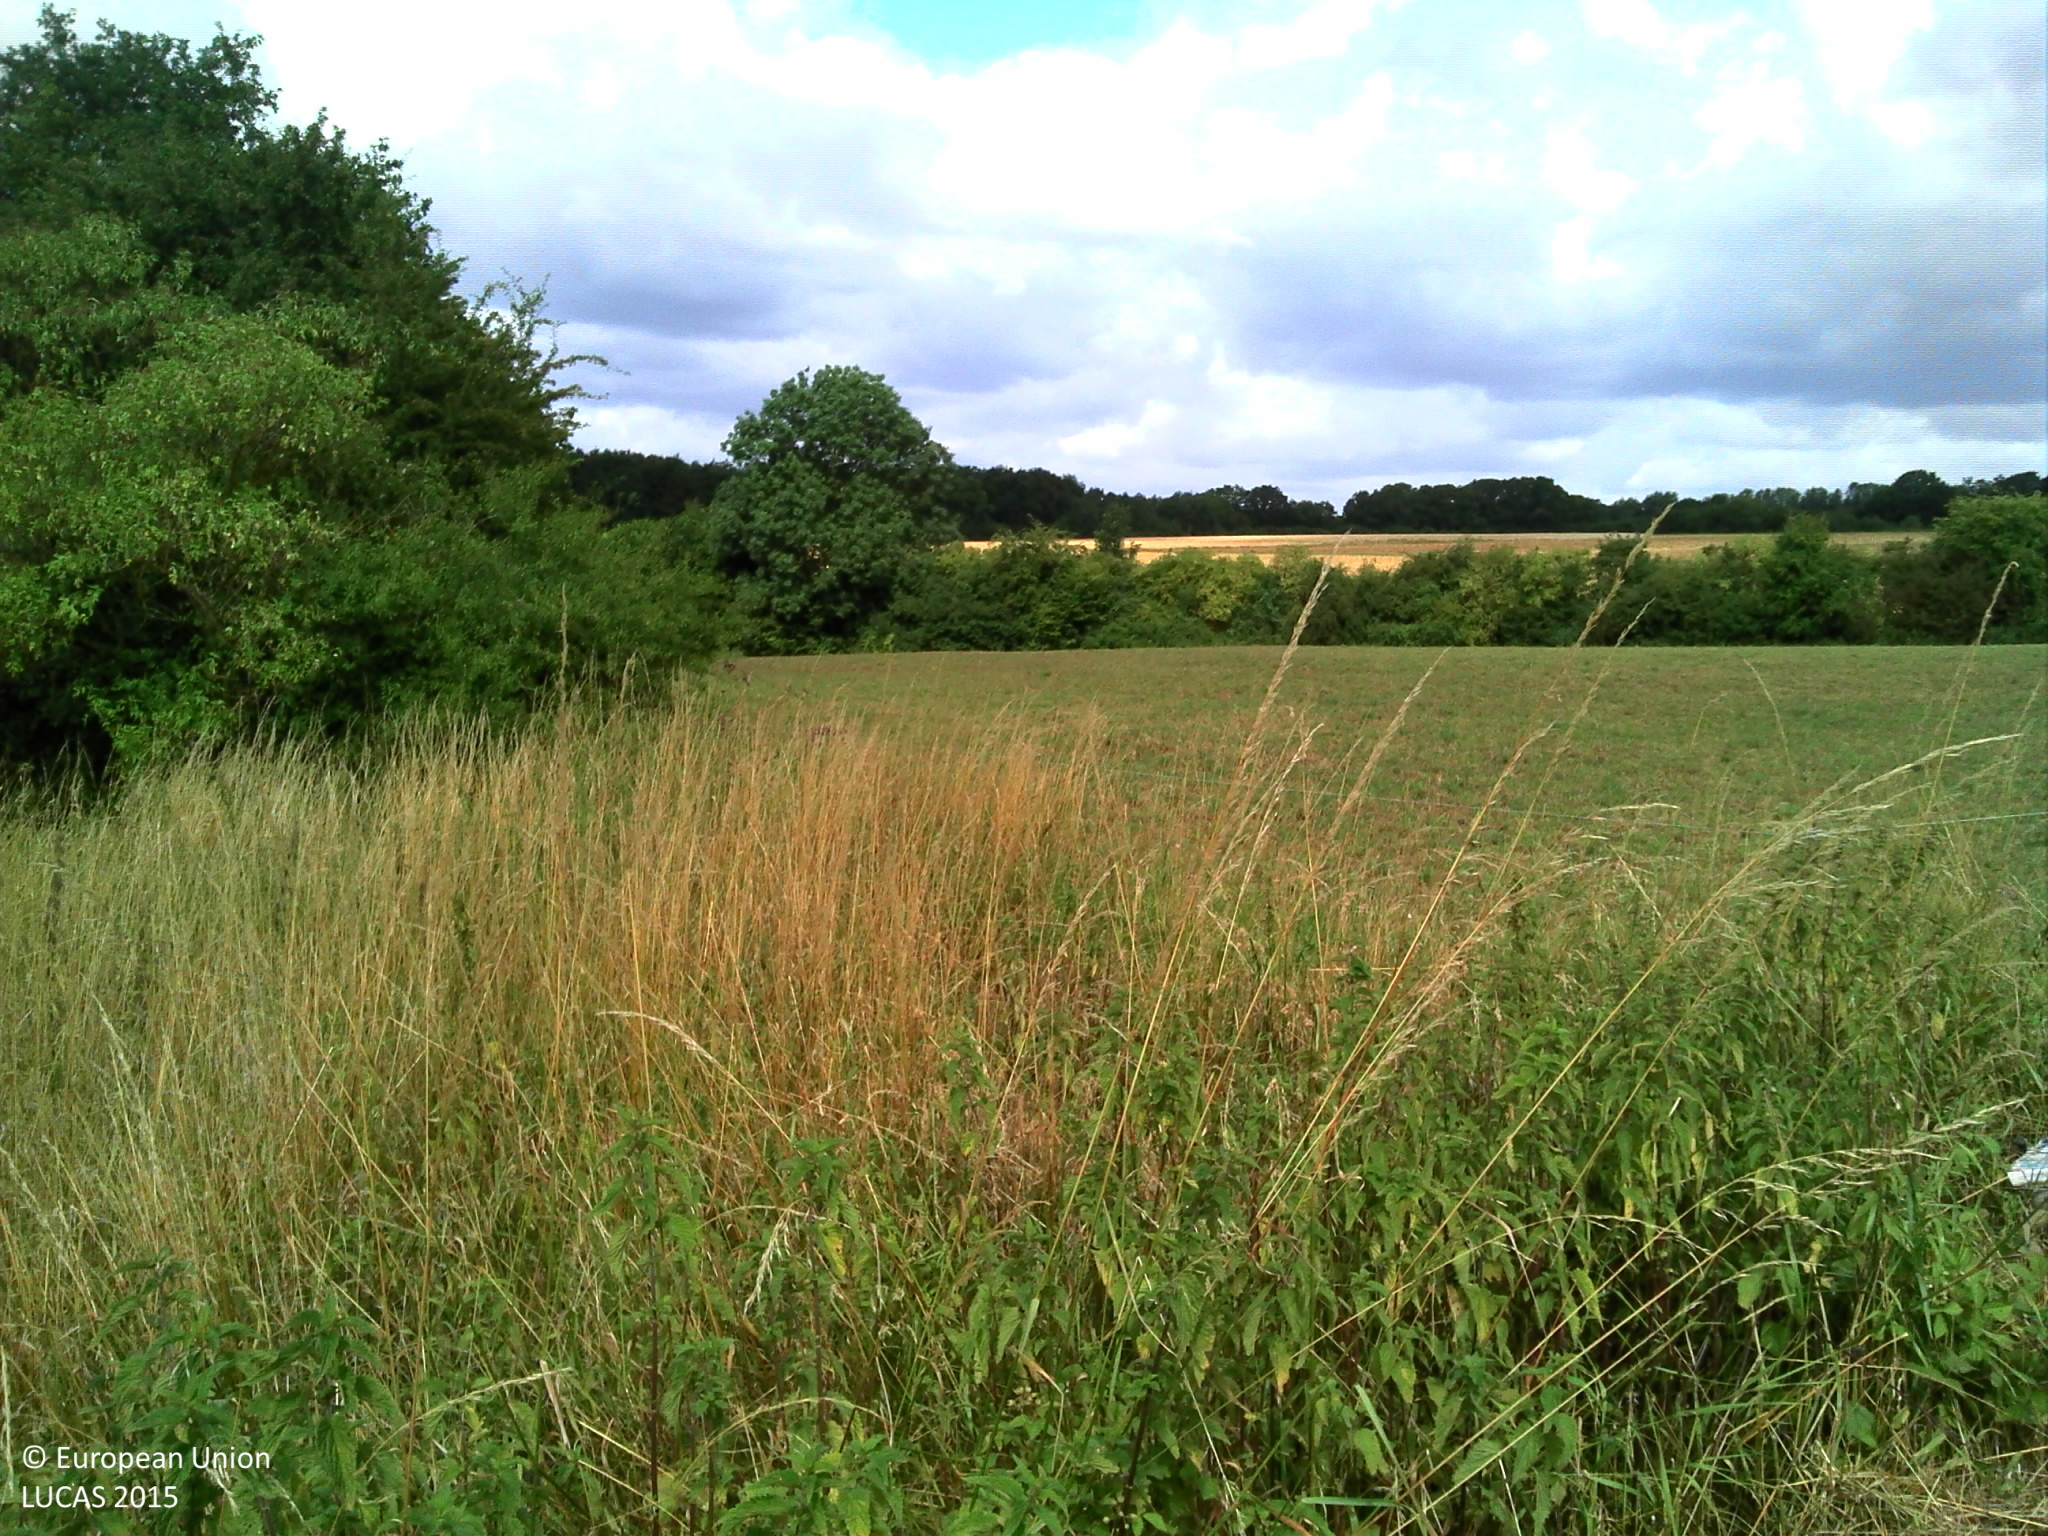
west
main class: Cropland
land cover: Temporary grasslands
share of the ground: > 75 %
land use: Agriculture (excluding fallow land and kitchen gardens)
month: July
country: BE
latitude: 49.5860
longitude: 5.8355
